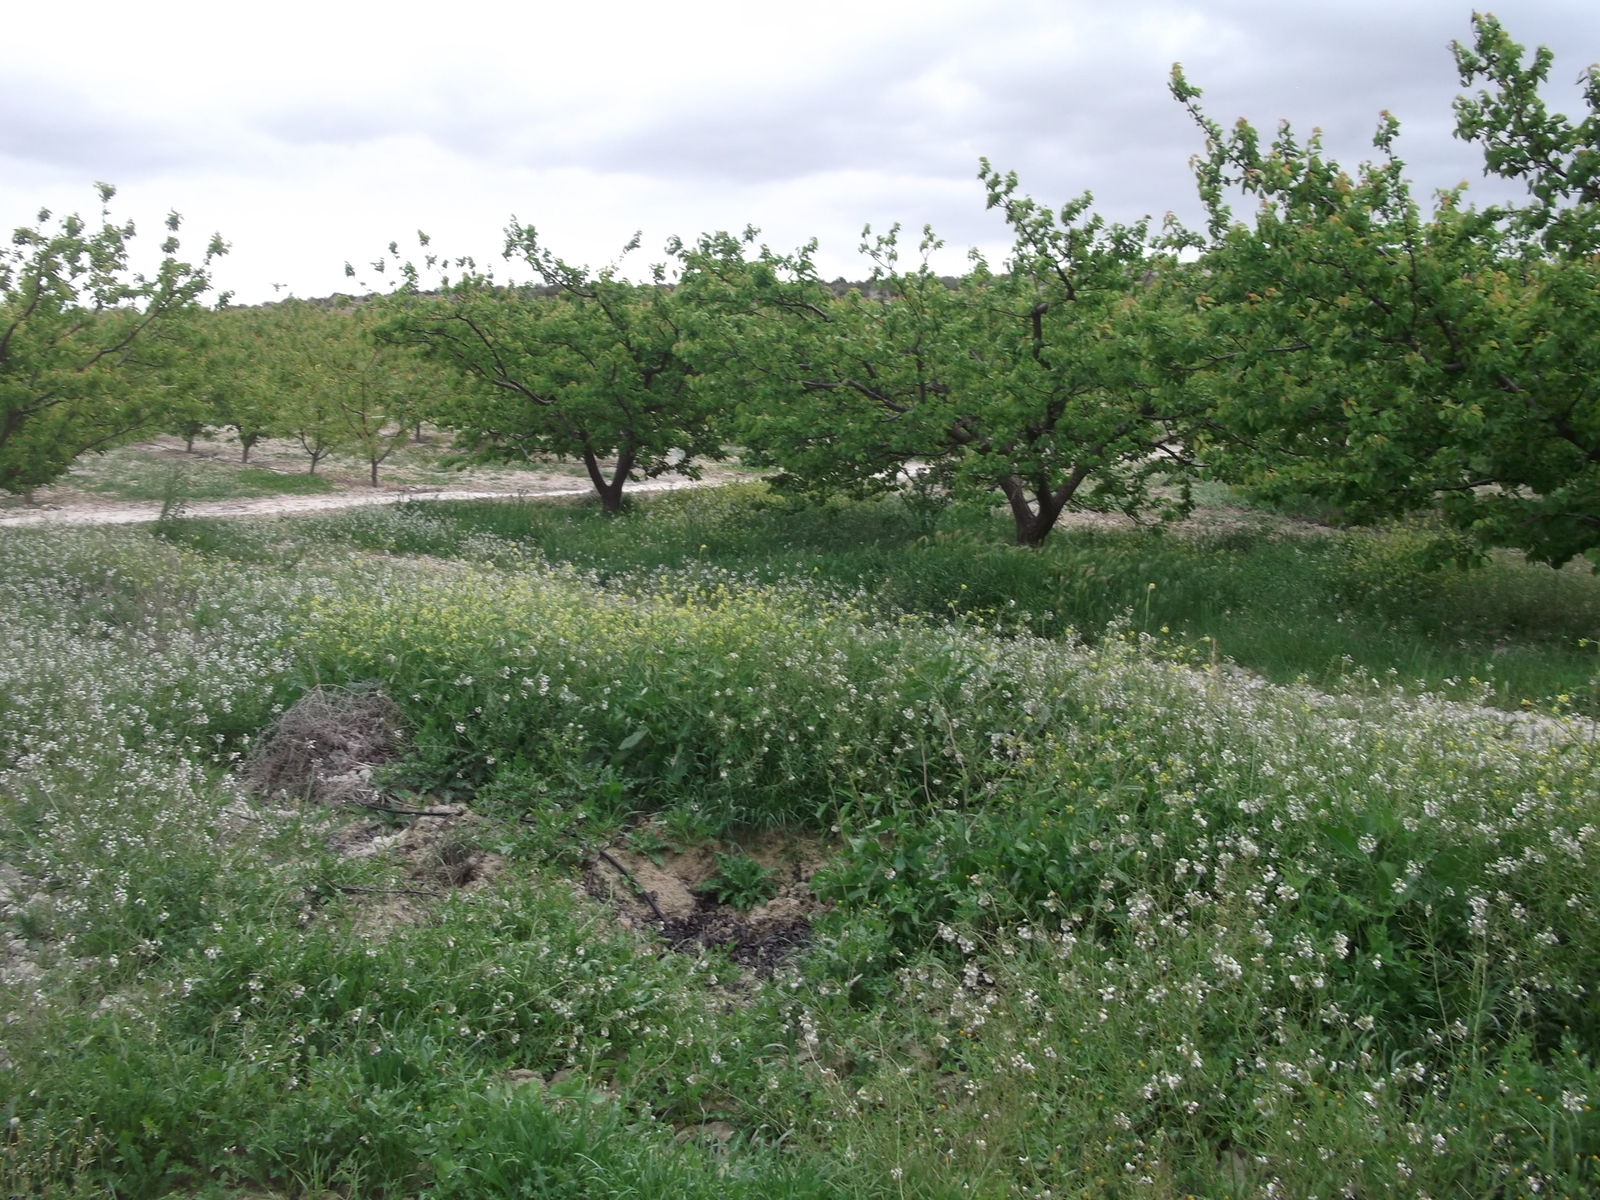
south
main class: Cropland
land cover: Other fruit trees and berries
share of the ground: 10 - 25 %
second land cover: Spontaneously vegetated surfaces
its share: > 75 %
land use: Agriculture (excluding fallow land and kitchen gardens)
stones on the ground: < 10 %
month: April
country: ES
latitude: 38.0609
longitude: -1.4407
